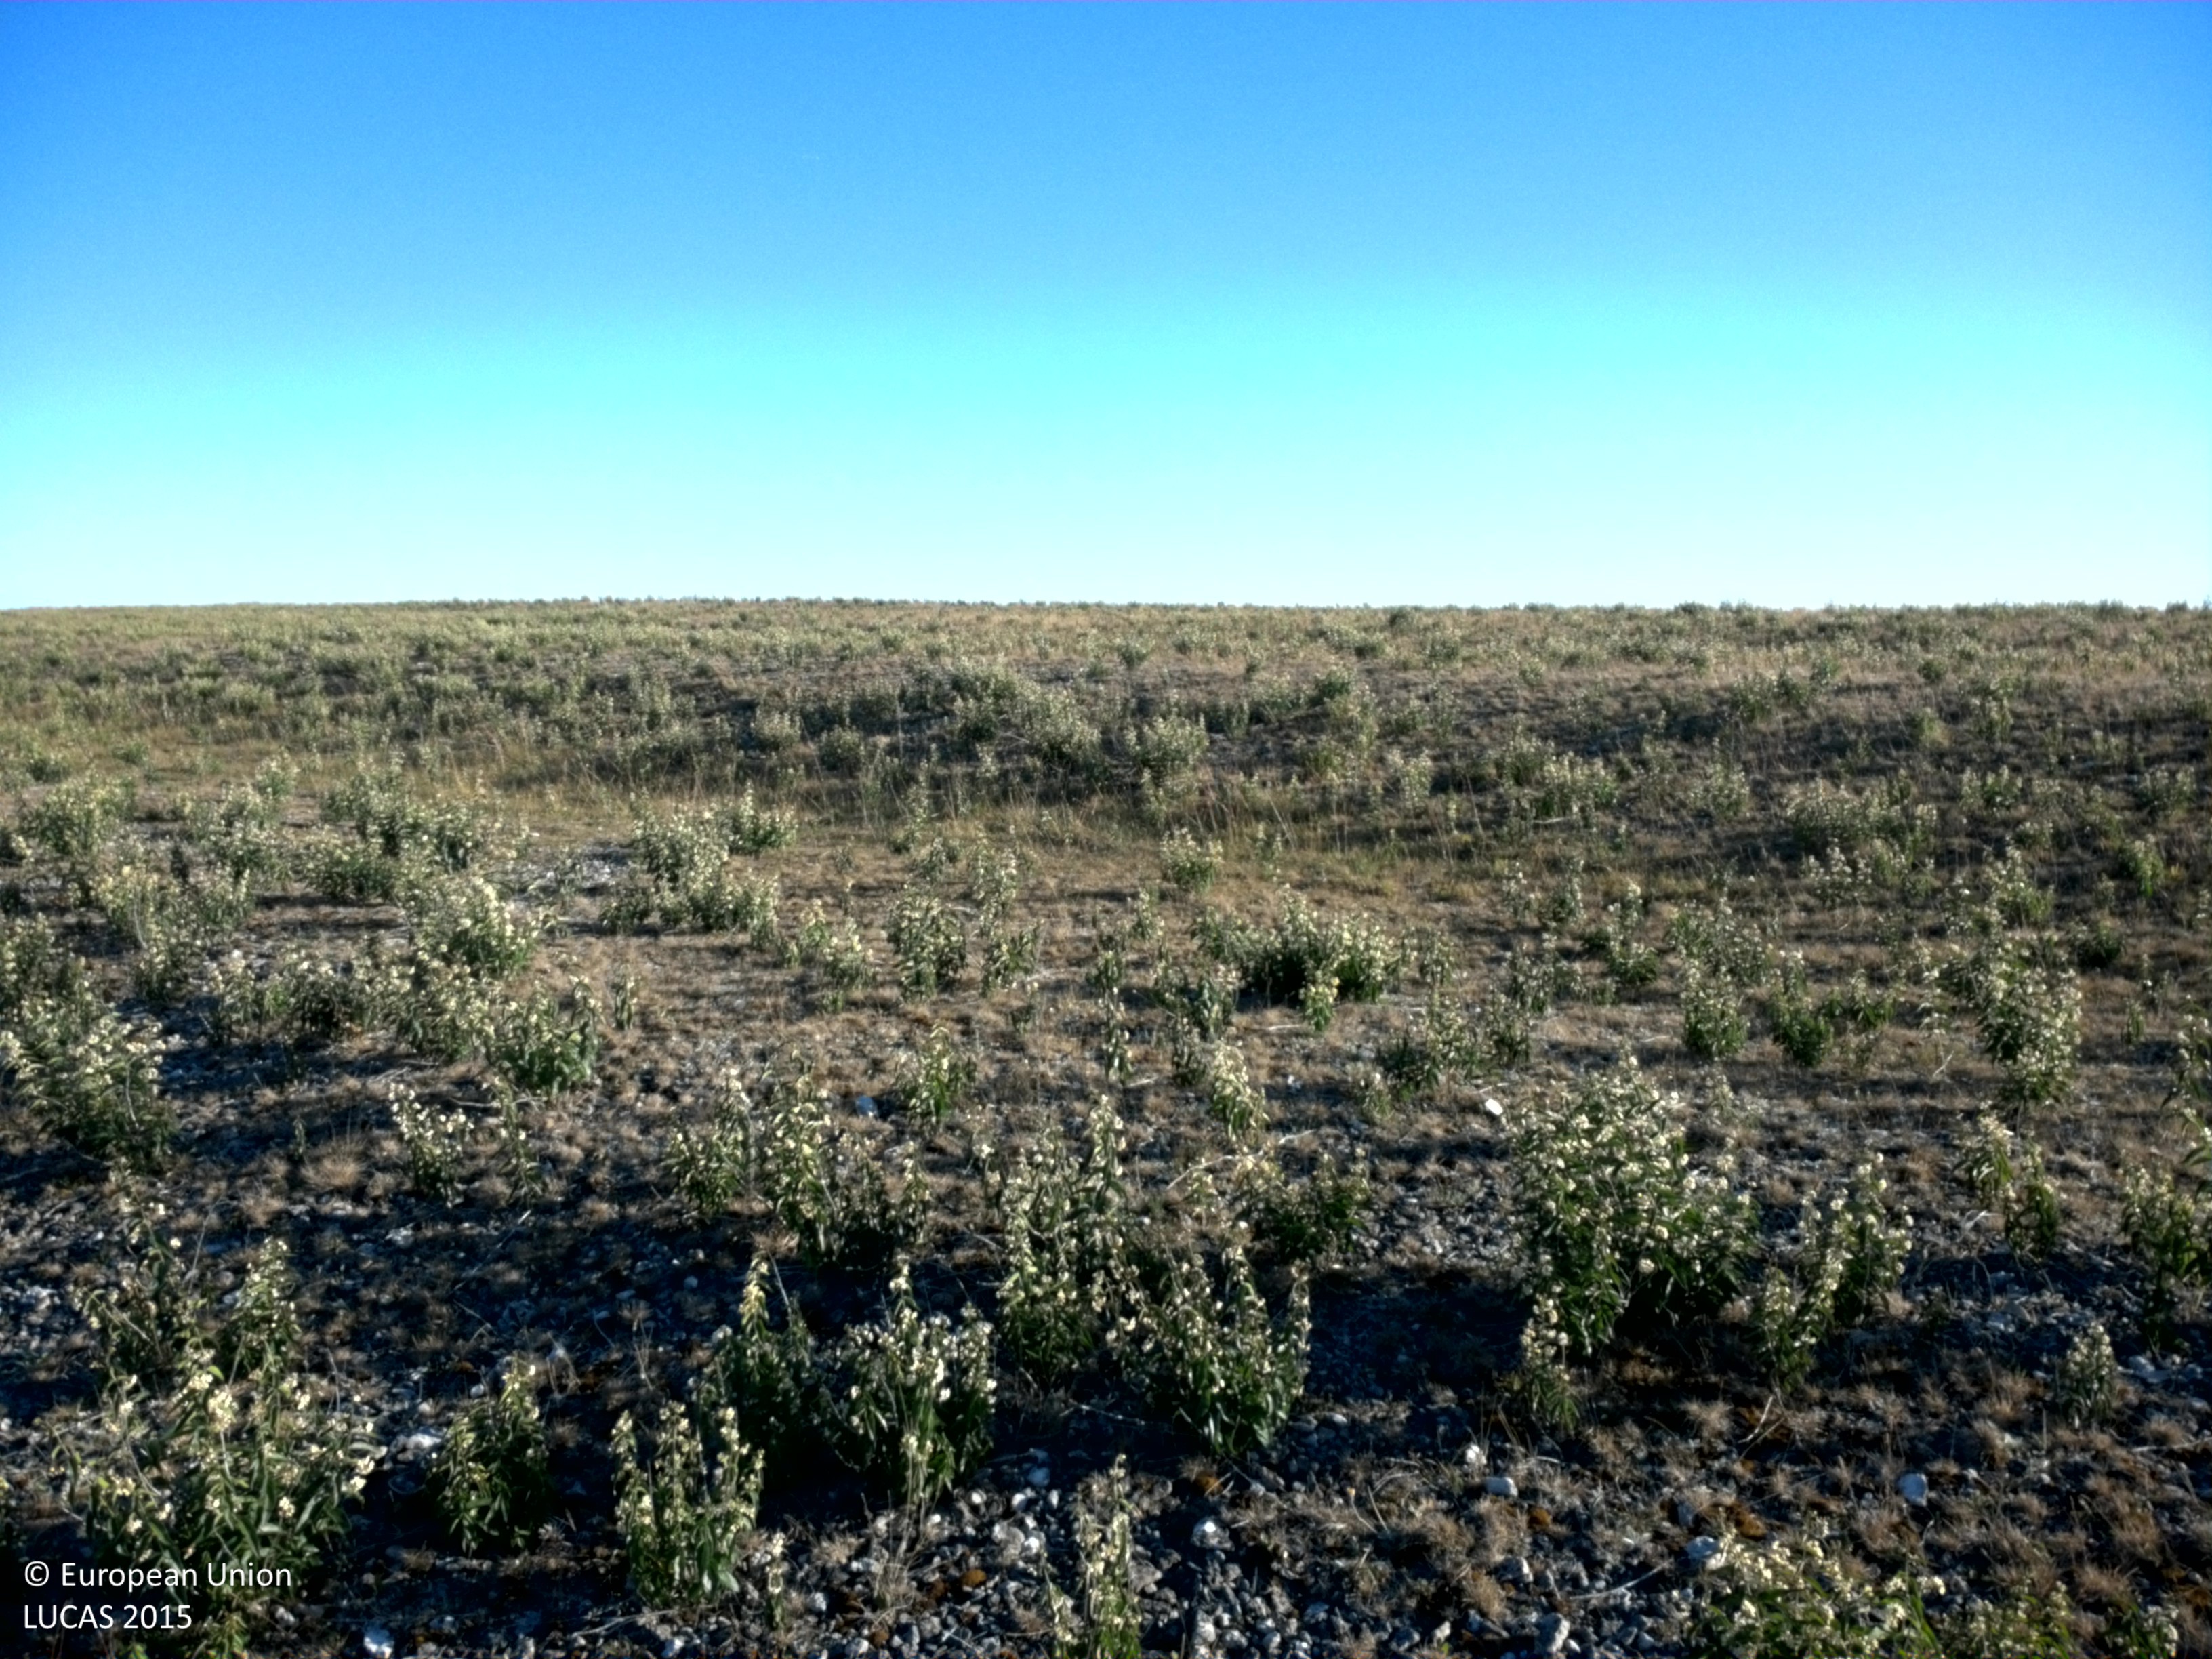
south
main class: Grassland
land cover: Grassland without tree/shrub cover
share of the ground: > 75 %
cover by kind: herbaceous plants 80 %, unconsolidated bare surface 15 %, lichens and mosses 5 %
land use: Agriculture (excluding fallow land and kitchen gardens)
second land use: Amenities, museums, leisure
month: July
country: SE
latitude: 57.7096
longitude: 18.8552
